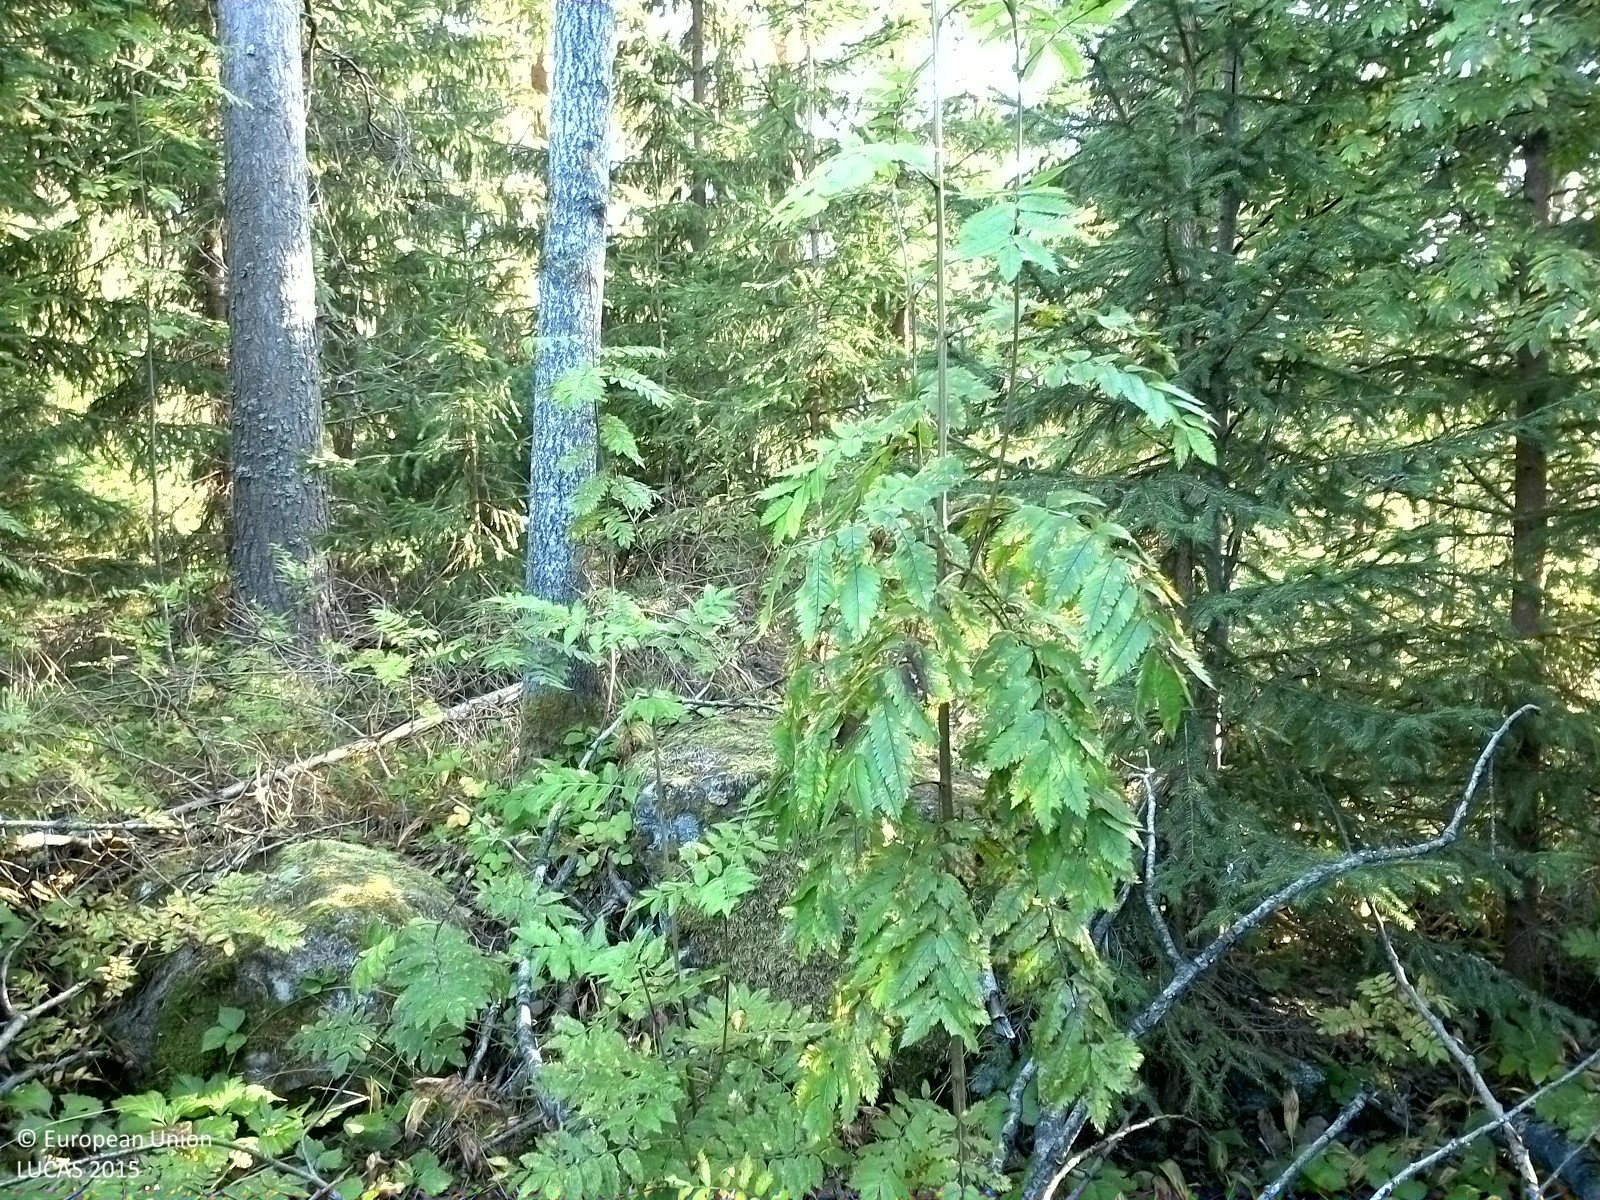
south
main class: Woodland
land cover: Other mixed woodland
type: boreal forest
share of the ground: 50 - 75 %
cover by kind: coniferous forest trees 40 %, broadleaved forest trees 20 %, herbaceous plants 20 %
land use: Forestry
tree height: > 5 m
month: August
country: SE
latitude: 62.3414
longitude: 16.9899
